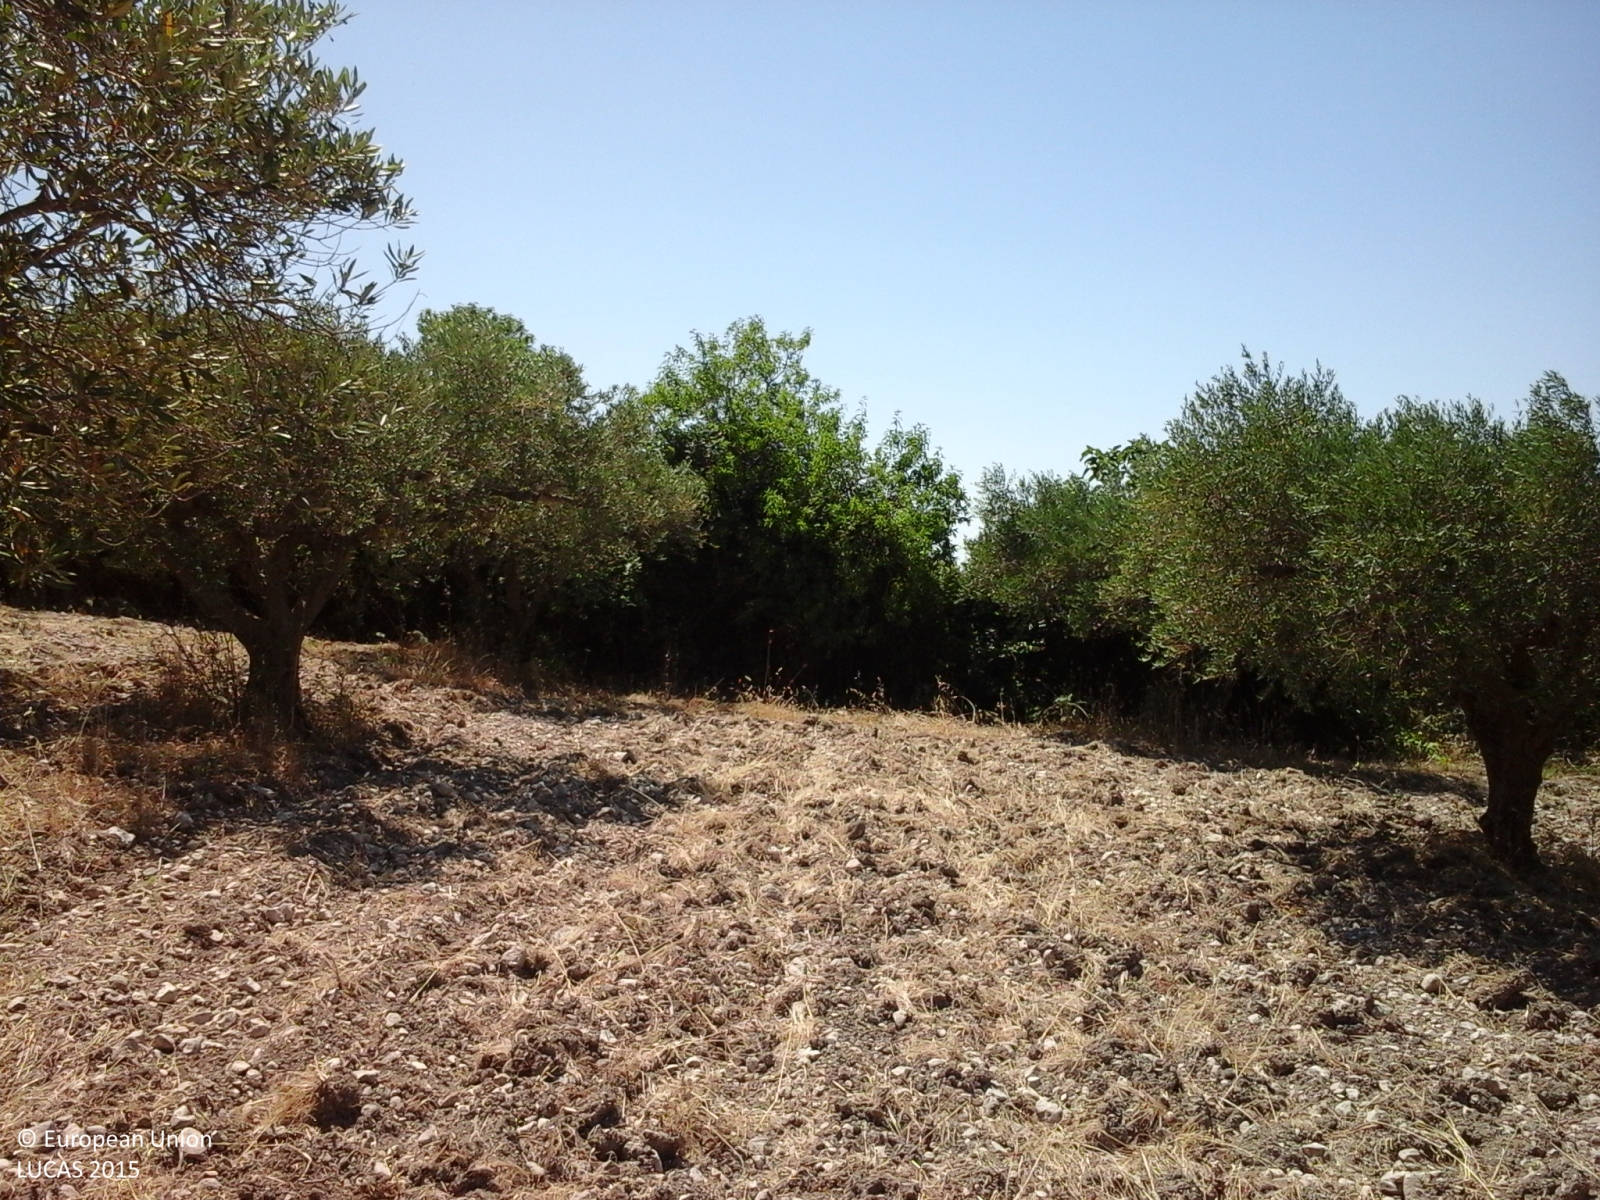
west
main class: Cropland
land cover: Olive groves
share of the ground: 50 - 75 %
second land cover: Other bare soil
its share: > 75 %
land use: Agriculture (excluding fallow land and kitchen gardens)
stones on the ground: < 10 %
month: June
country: IT
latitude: 37.6405
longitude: 13.1607
